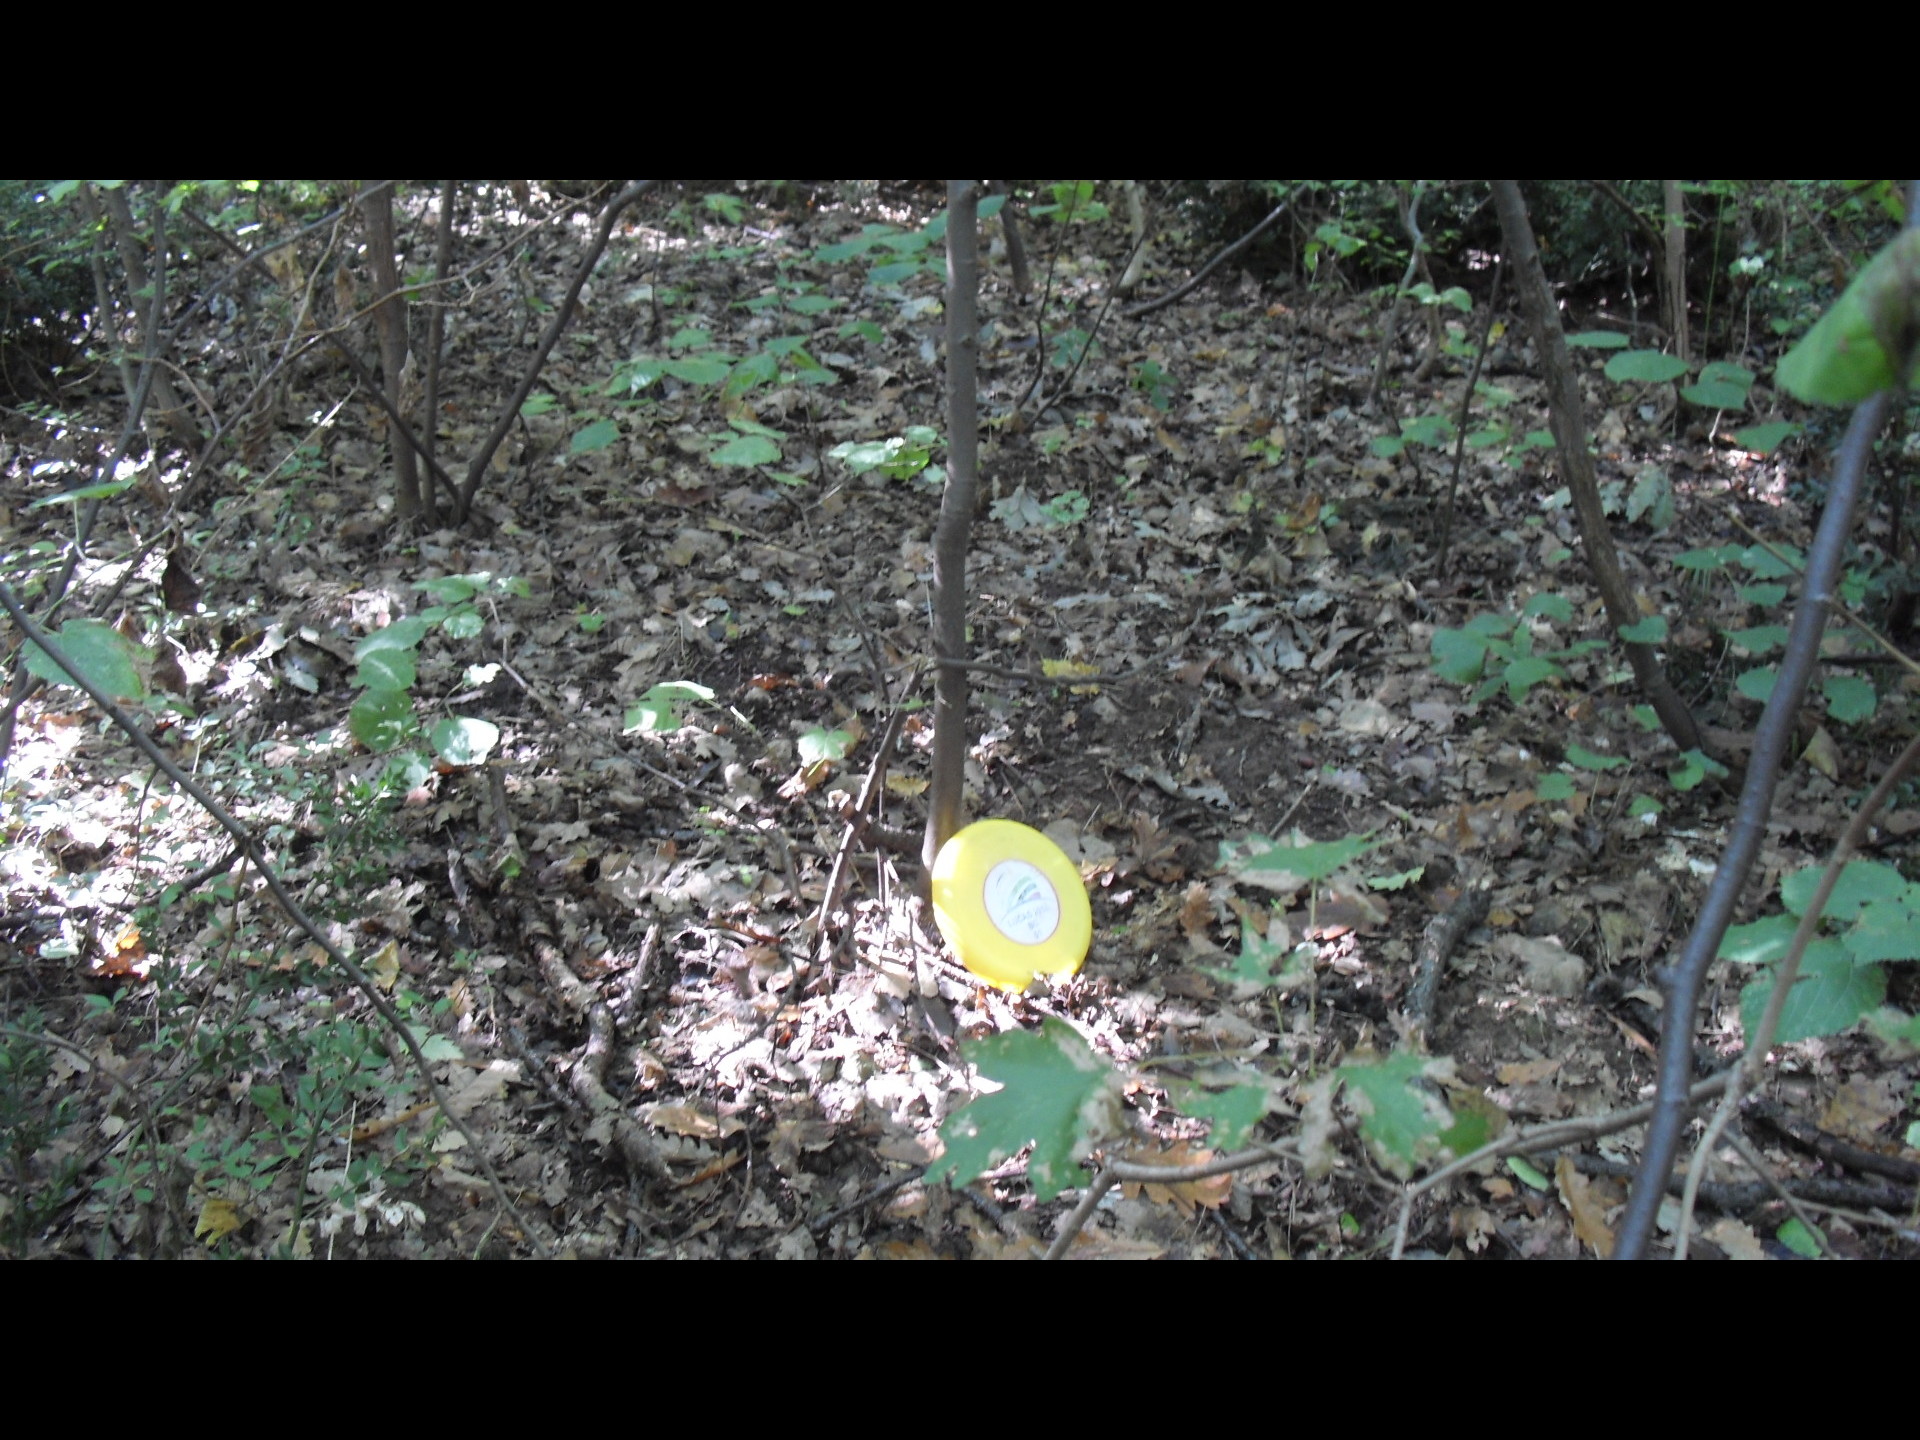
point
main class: Woodland
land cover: Broadleaved woodland
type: mesophytic deciduous forest
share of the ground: > 75 %
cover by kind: broadleaved forest trees 100 %
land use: Forestry
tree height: > 5 m
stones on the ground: < 10 %
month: October
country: BG
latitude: 43.8893
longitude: 22.7461
